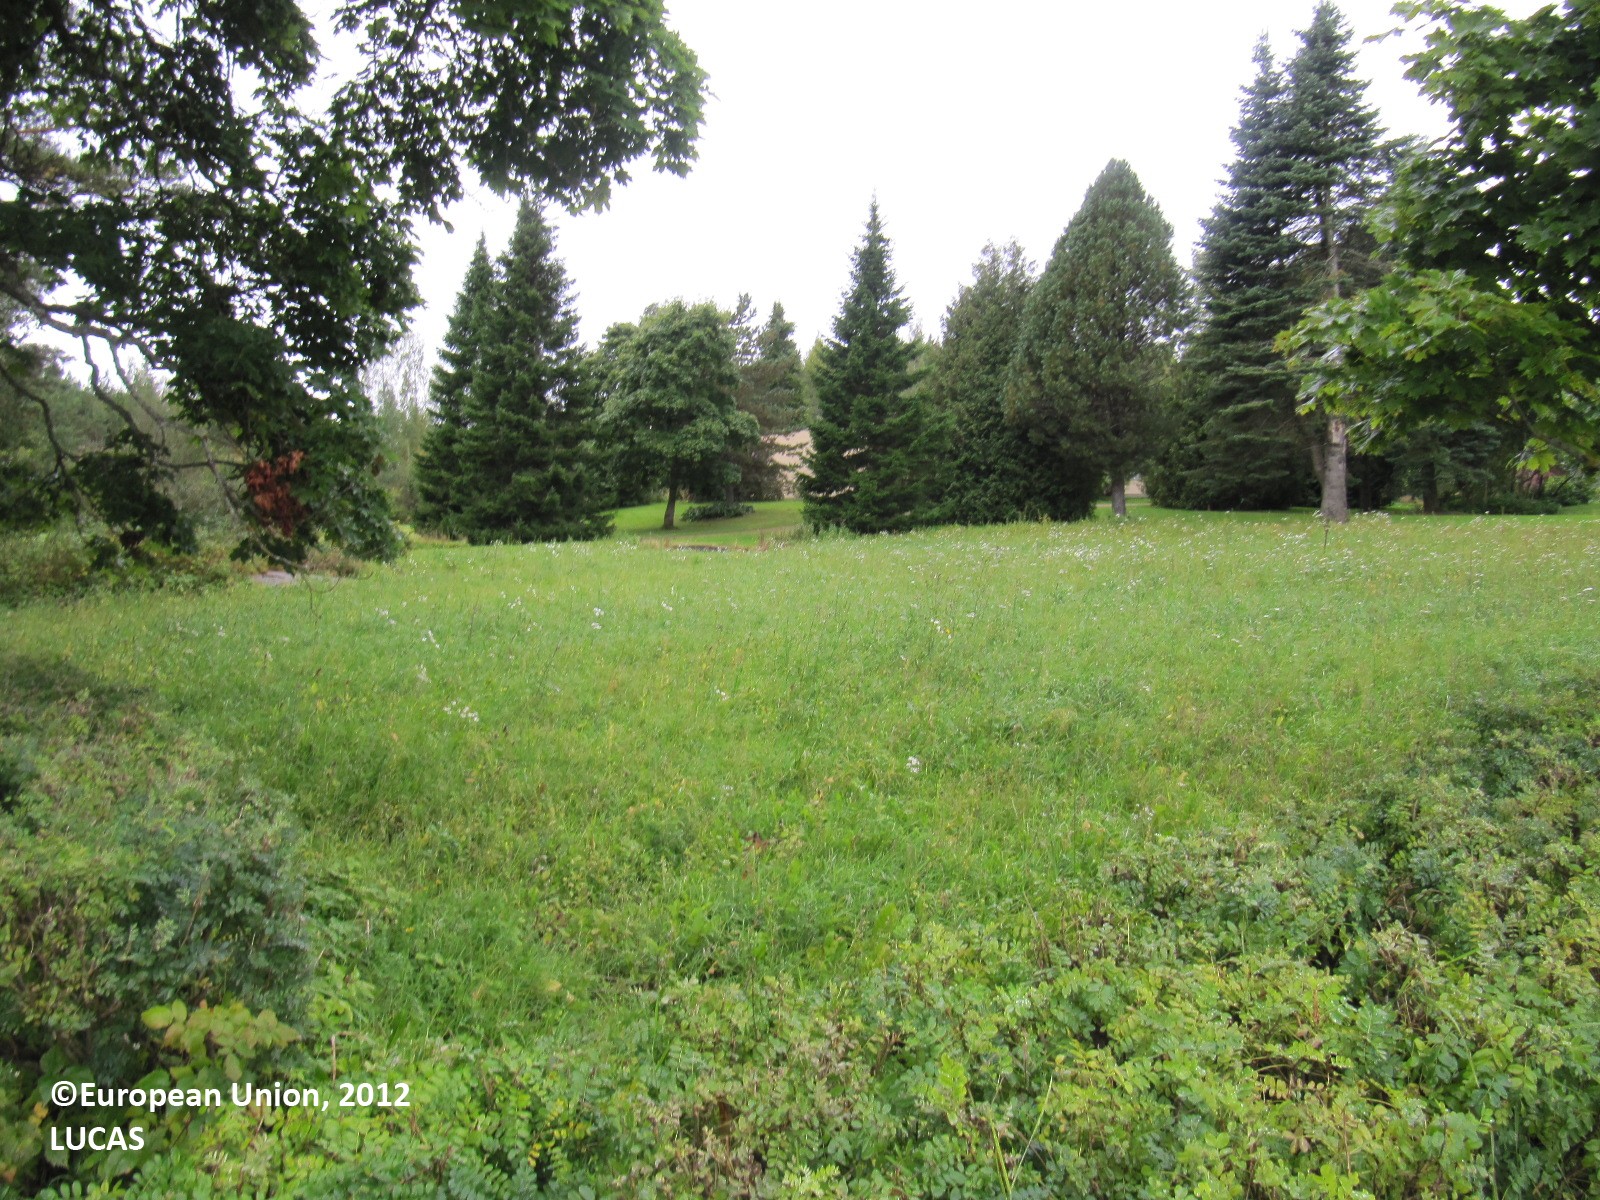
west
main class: Grassland
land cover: Grassland with sparse tree/shrub cover
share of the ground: > 75 %
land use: Residential
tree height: > 5 m
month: September
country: FI
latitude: 60.0724
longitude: 24.0992
